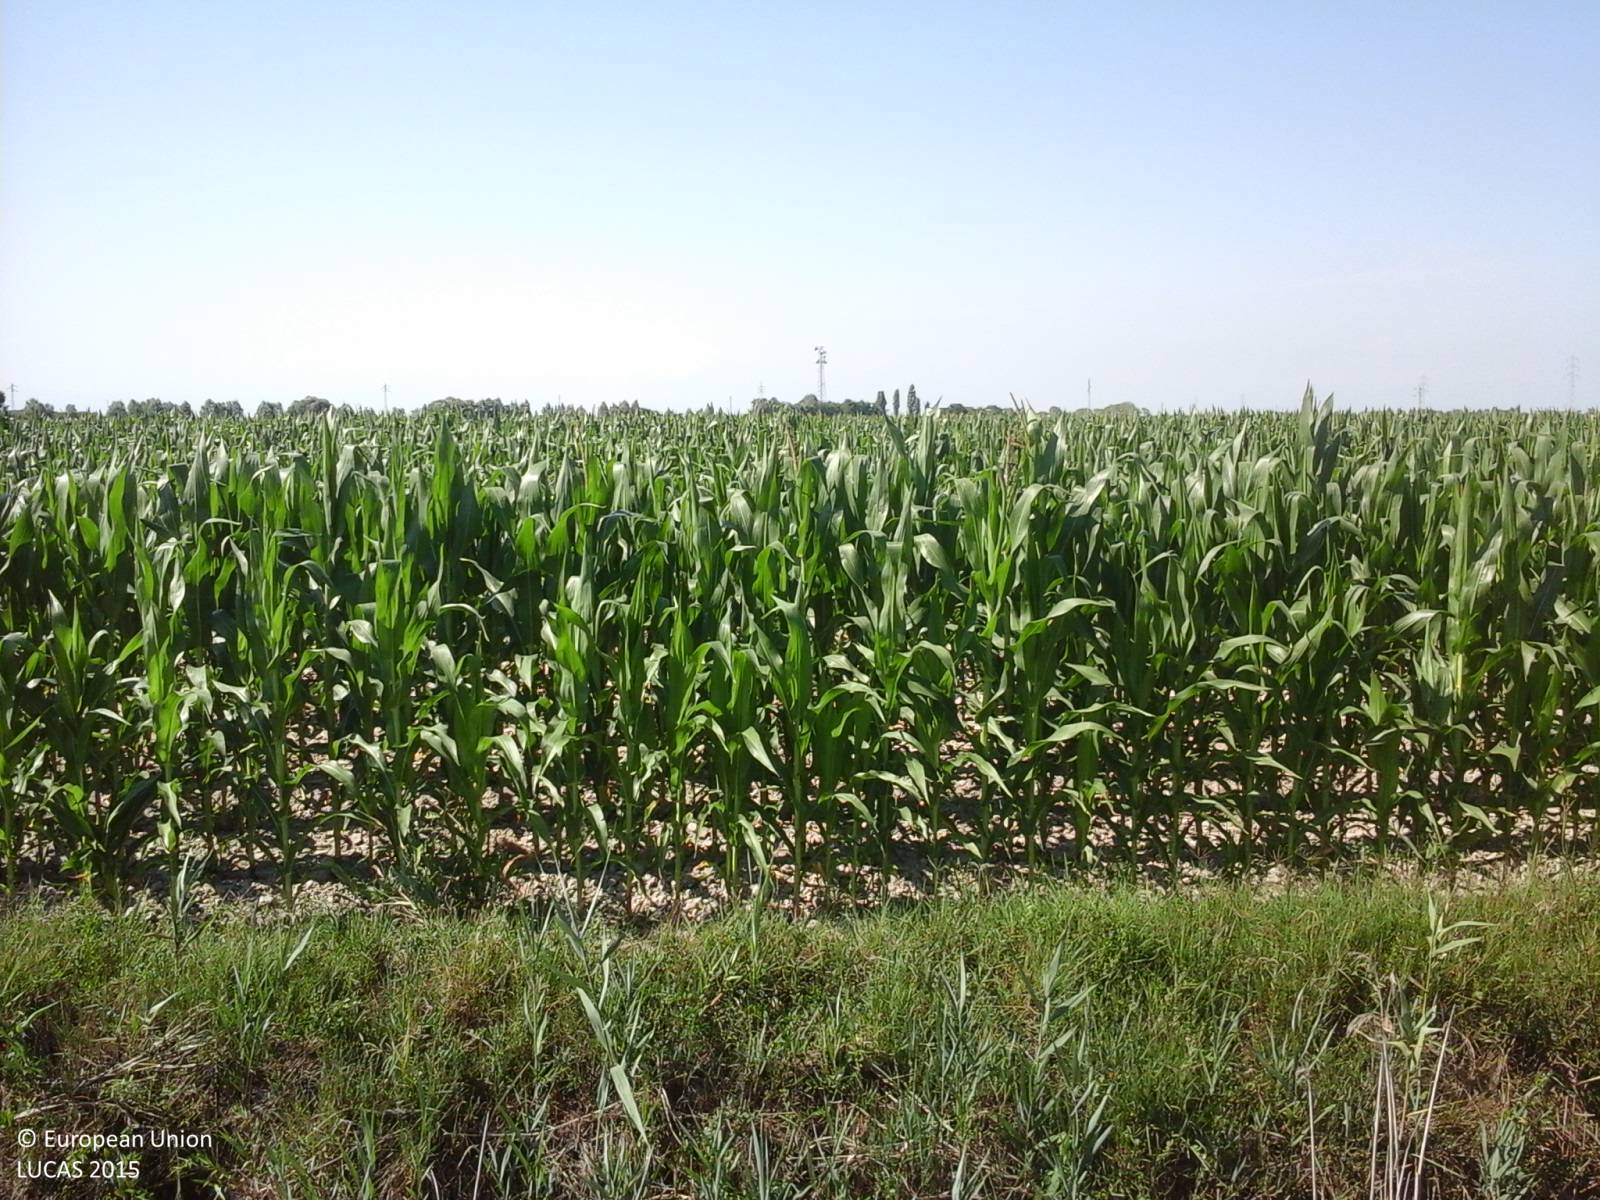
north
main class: Cropland
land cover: Maize
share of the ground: > 75 %
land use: Agriculture (excluding fallow land and kitchen gardens)
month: July
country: IT
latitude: 45.6598
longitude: 13.0120
